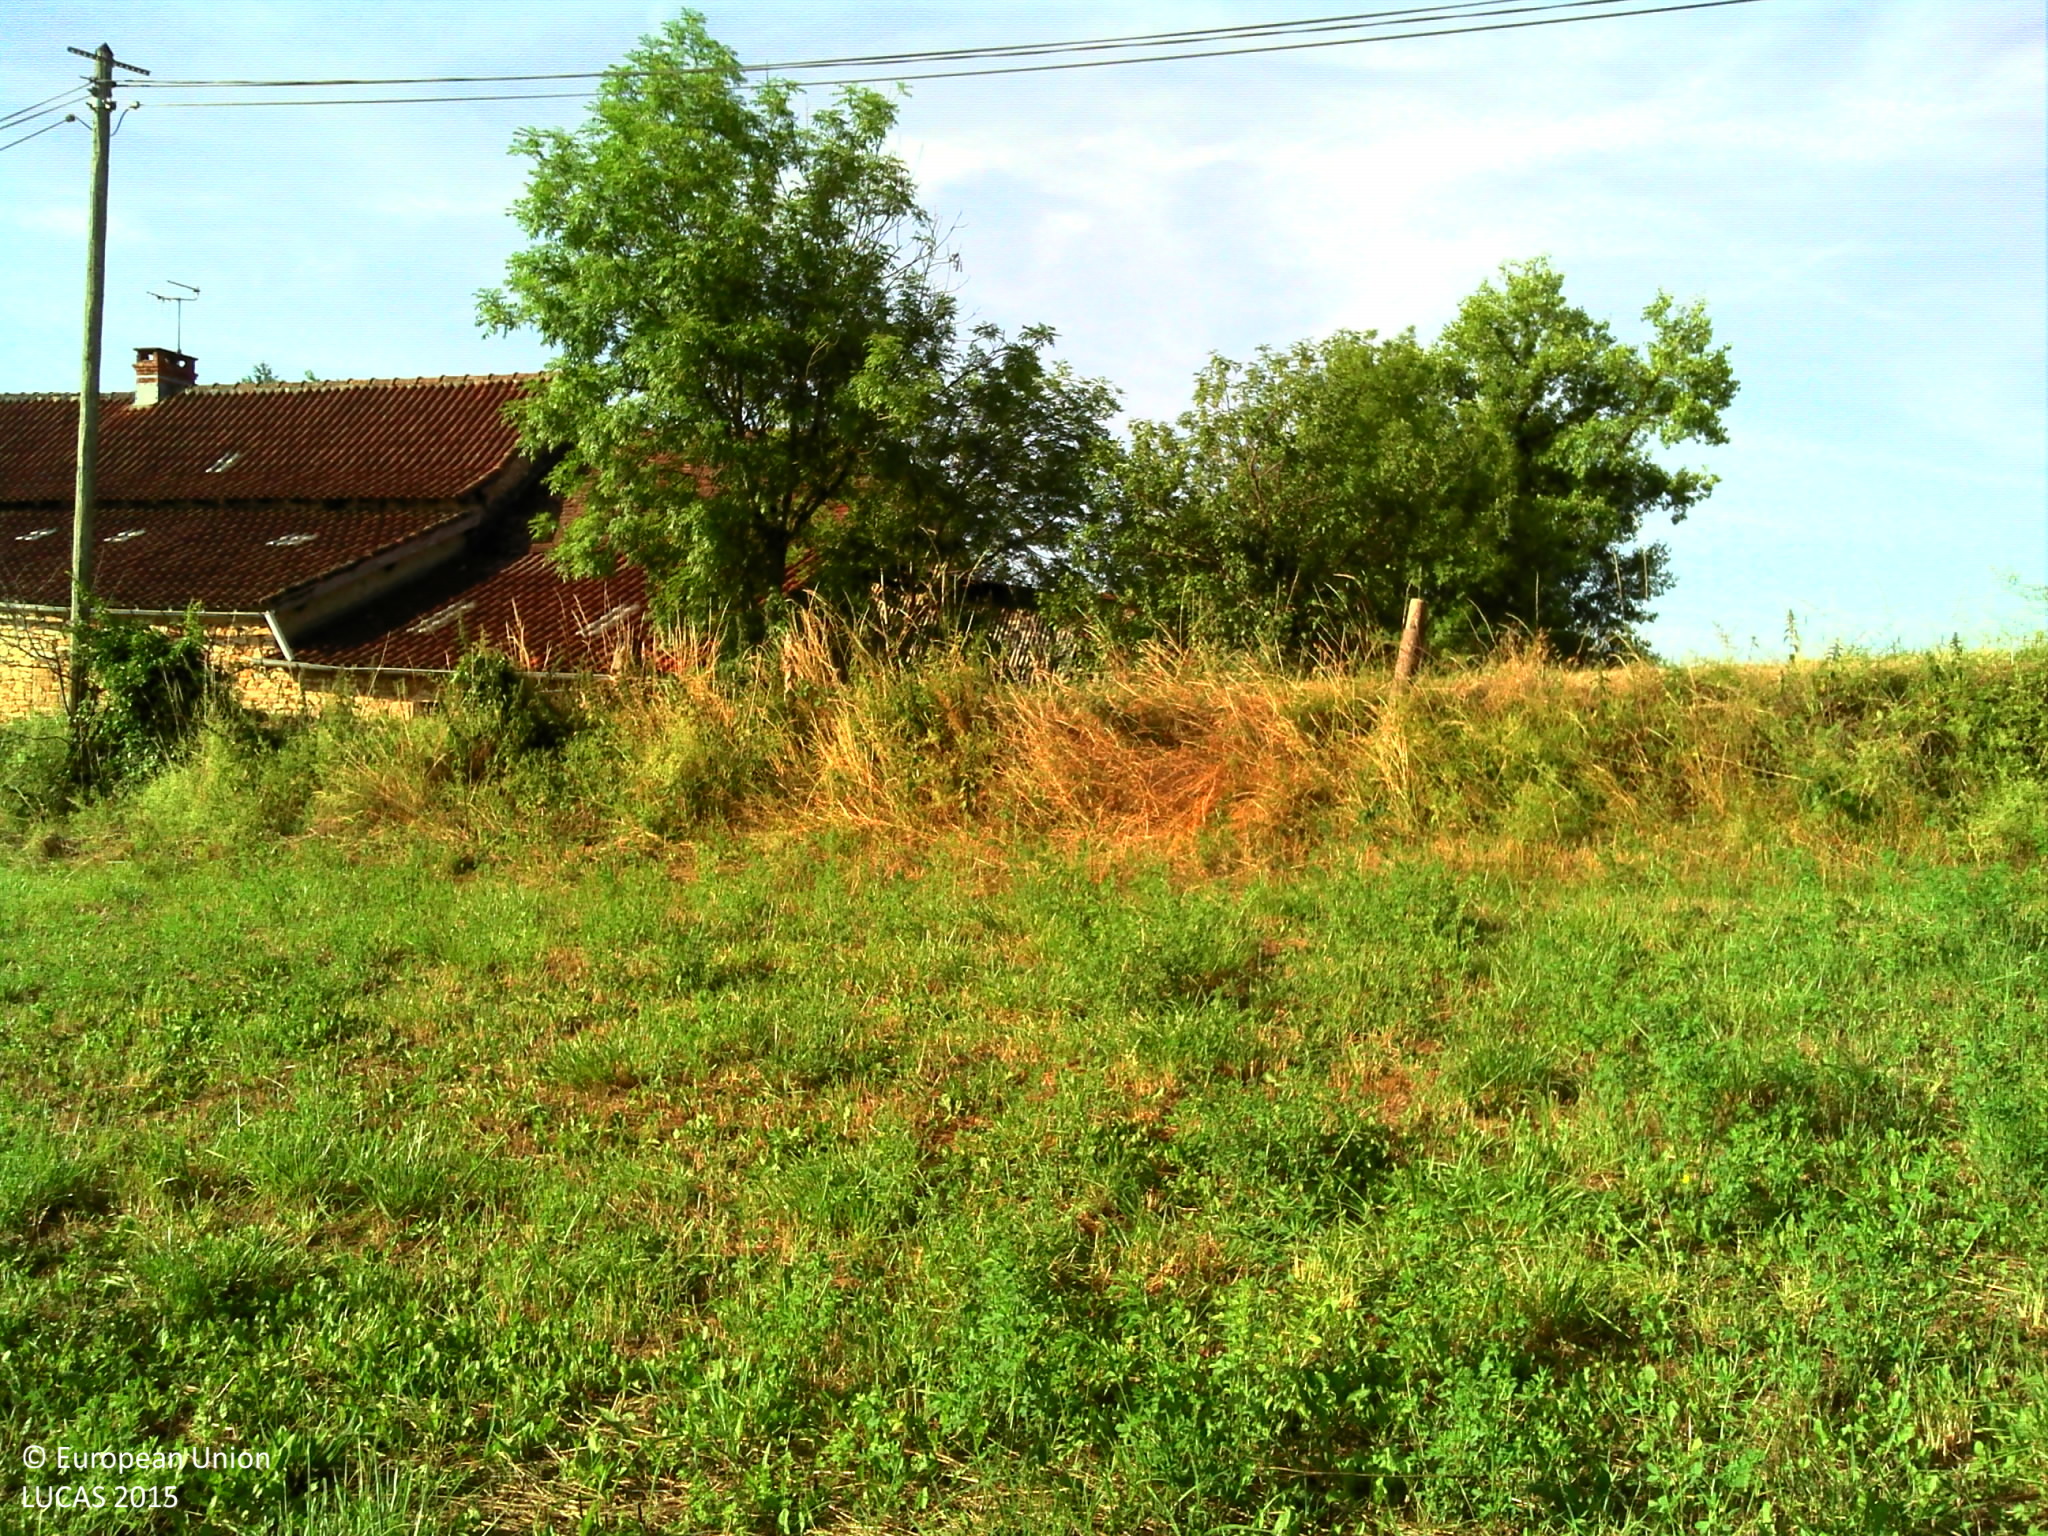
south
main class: Cropland
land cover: Lucerne
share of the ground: 50 - 75 %
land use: Agriculture (excluding fallow land and kitchen gardens)
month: June
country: FR
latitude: 44.4058
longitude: 2.0276
